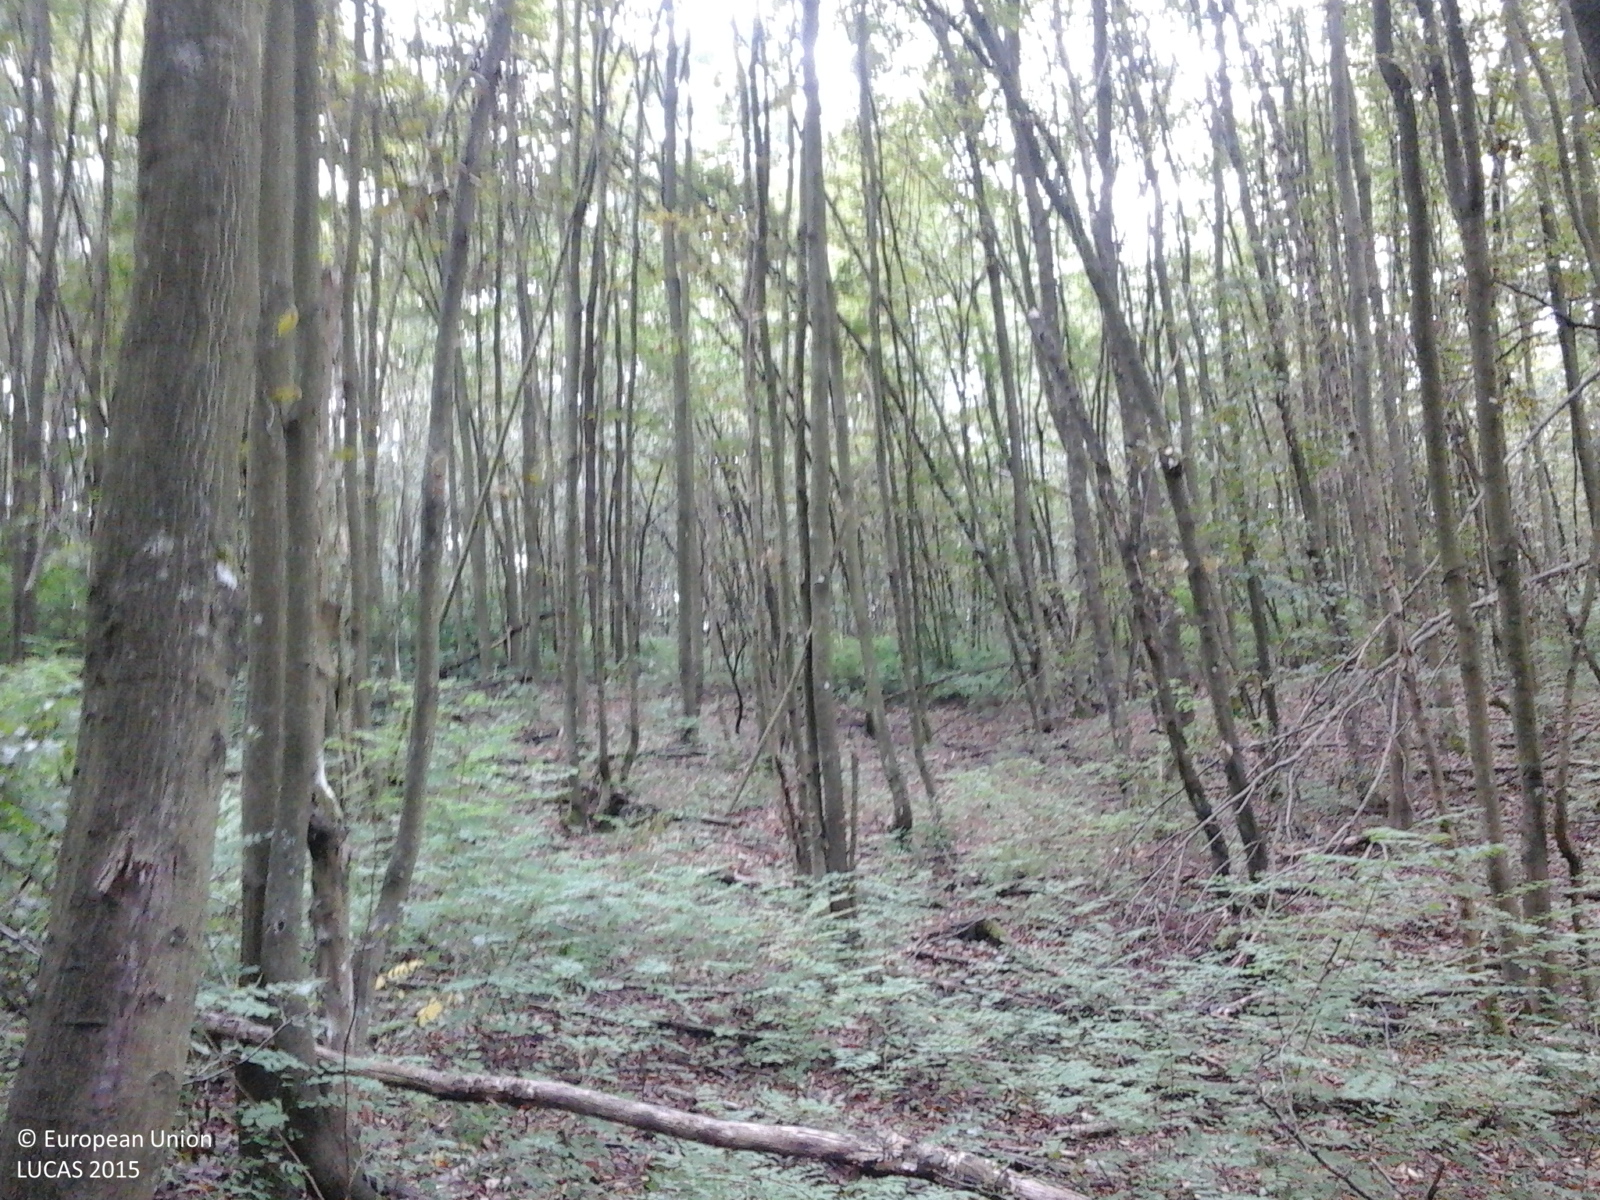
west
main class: Woodland
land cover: Broadleaved woodland
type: mesophytic deciduous forest
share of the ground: > 75 %
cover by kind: broadleaved forest trees 100 %
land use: Forestry
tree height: > 5 m
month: September
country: RO
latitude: 45.9137
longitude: 22.1228
